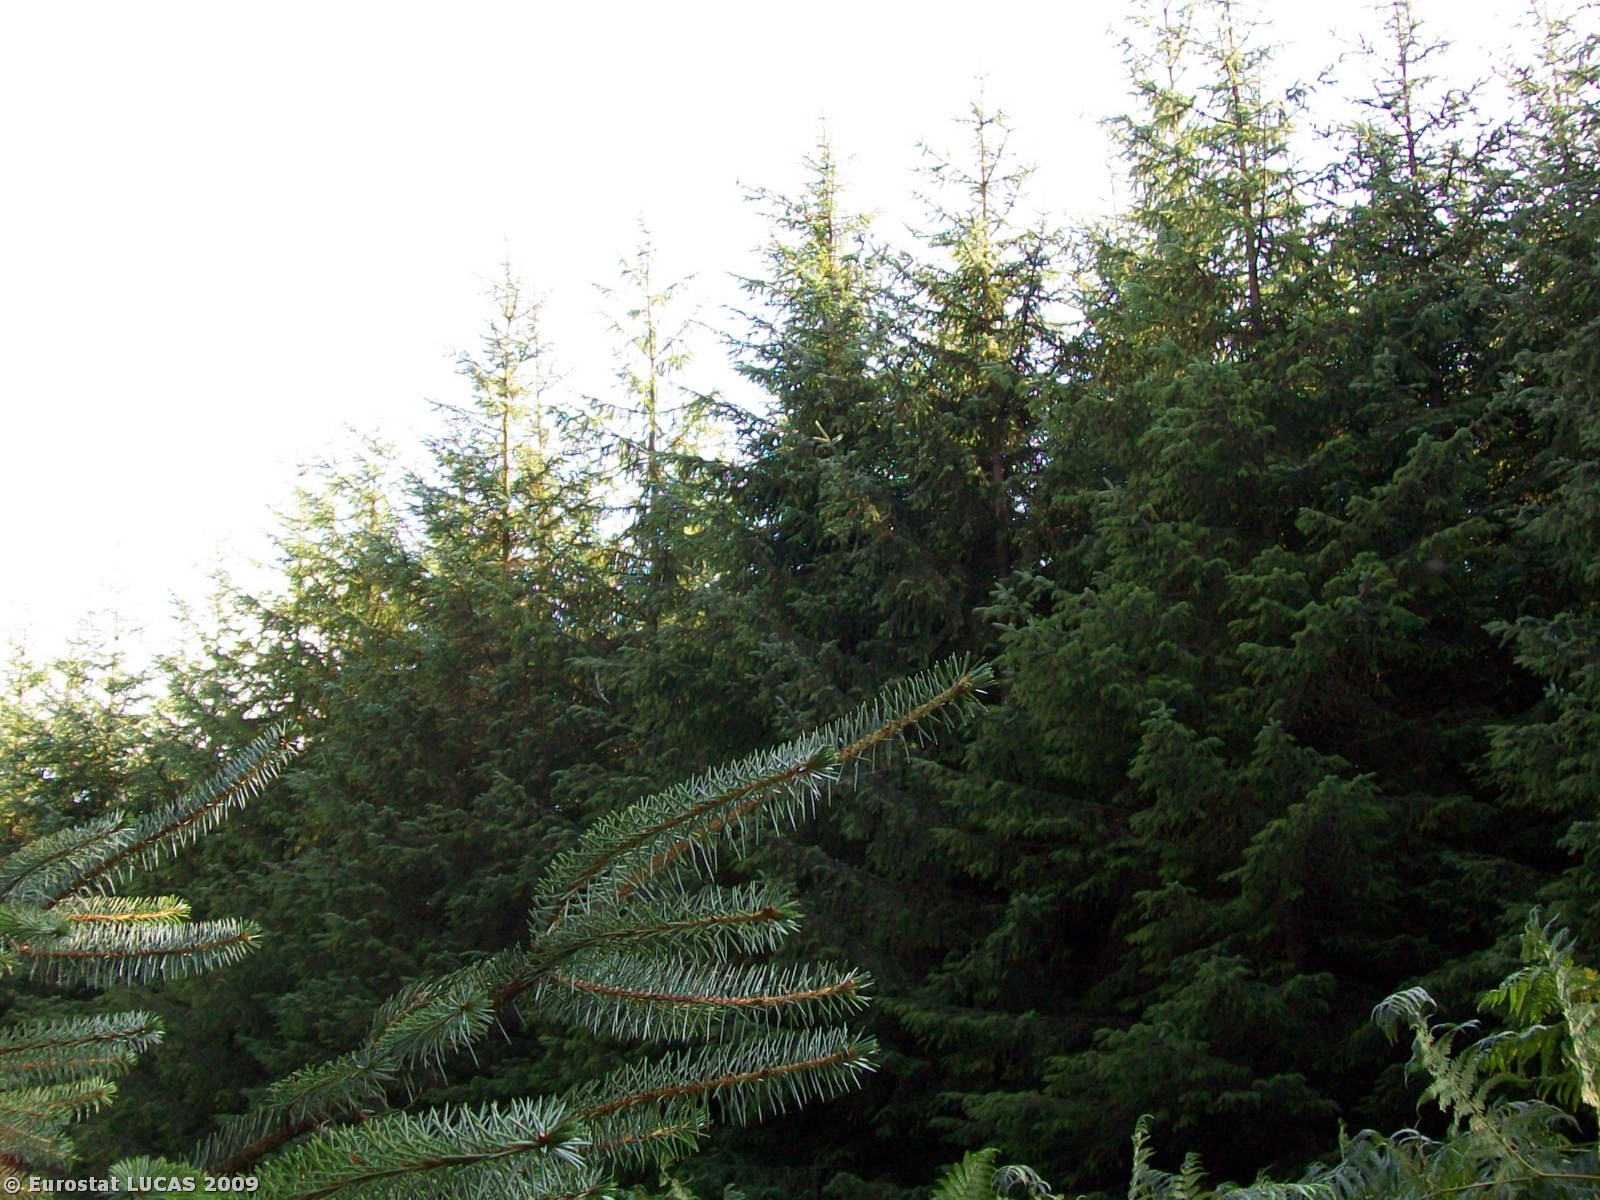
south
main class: Woodland
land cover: Coniferous woodland
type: plantations and self-sown exotic forest
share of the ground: > 75 %
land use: Forestry
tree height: > 5 m
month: August
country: GB
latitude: 55.3294
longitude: -1.8256
